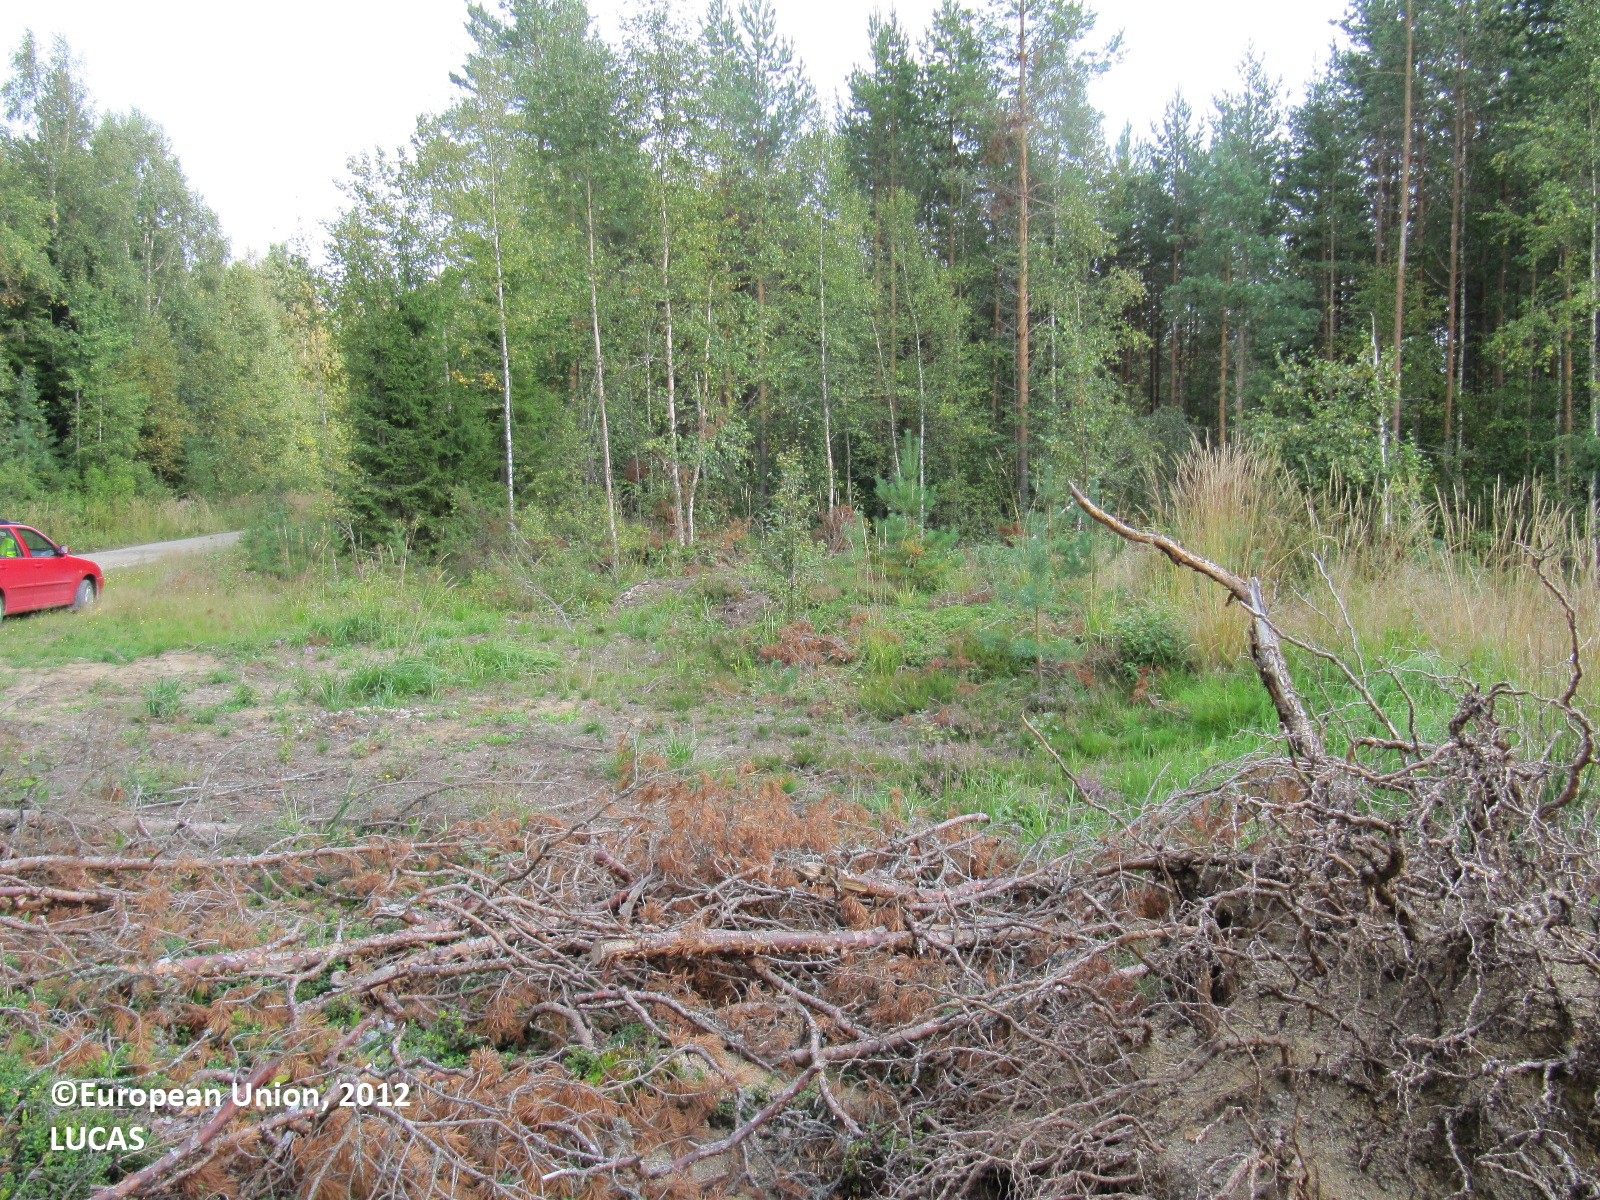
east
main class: Woodland
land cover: Spruce dominated mixed woodland
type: boreal forest
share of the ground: 50 - 75 %
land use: Forestry
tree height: > 5 m
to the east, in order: Spruce dominated mixed woodland; Pine dominated mixed woodland
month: August
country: FI
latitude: 61.1036
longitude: 22.8911
